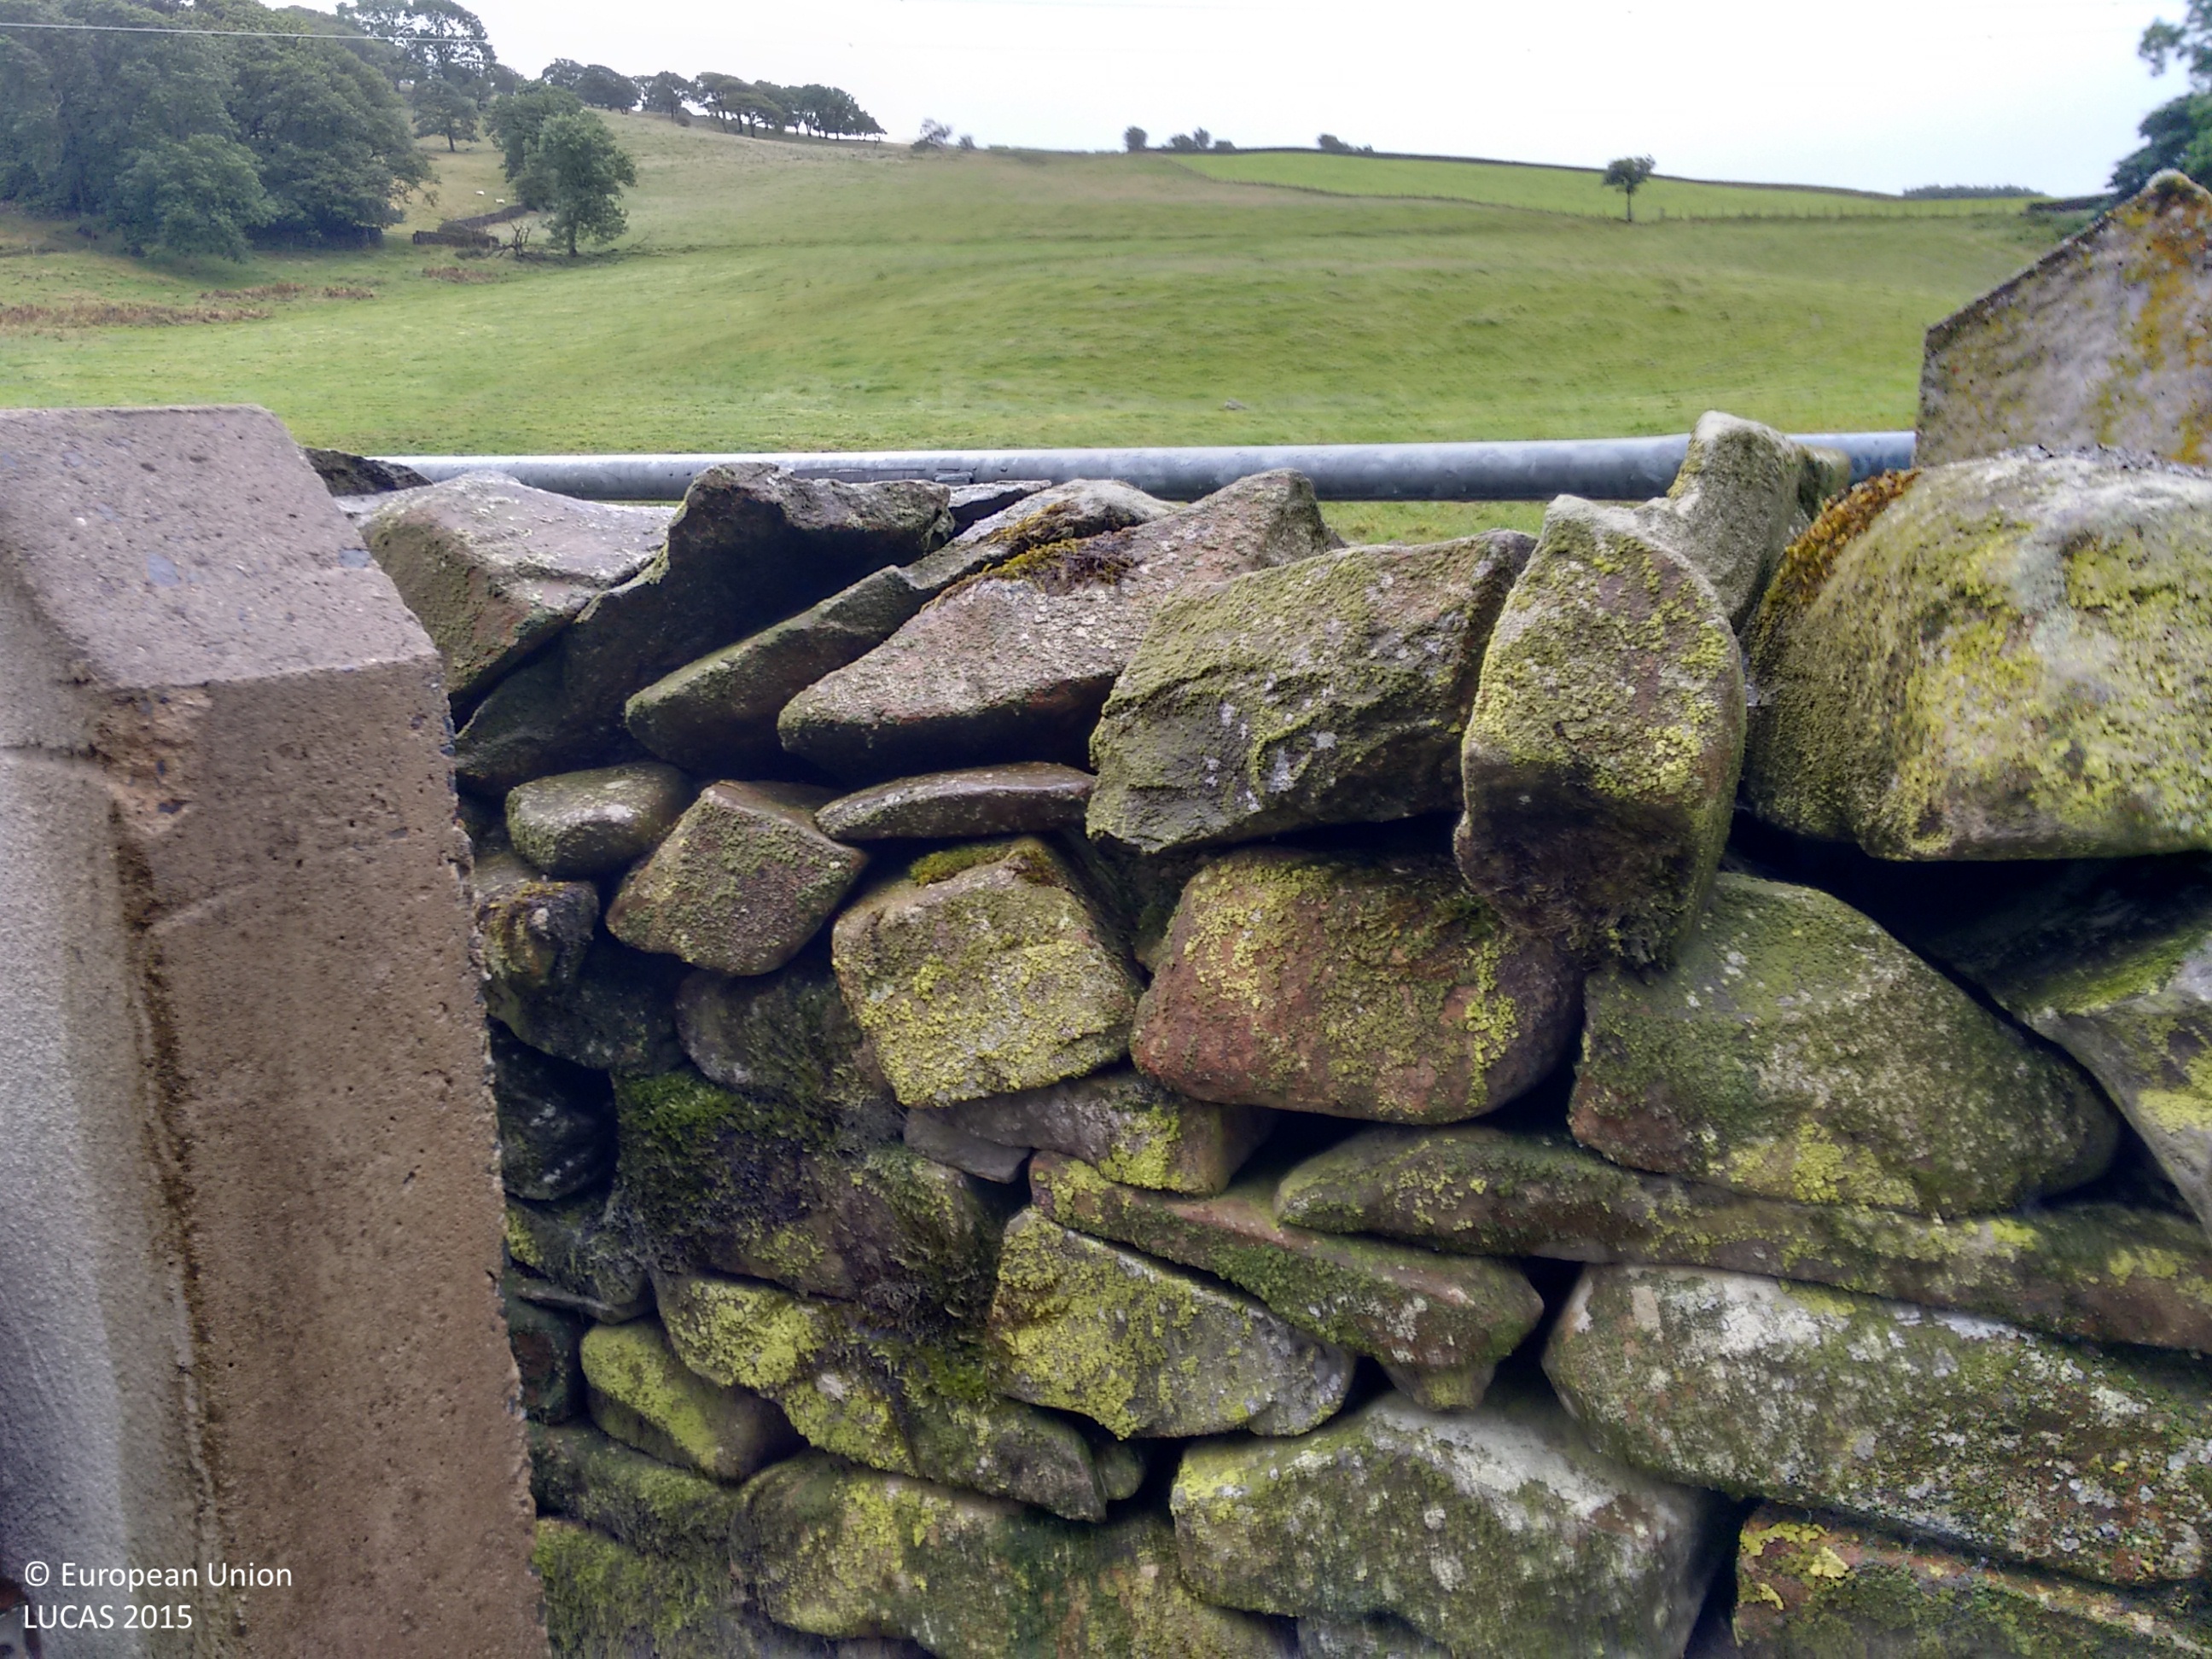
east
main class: Grassland
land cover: Grassland without tree/shrub cover
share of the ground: > 75 %
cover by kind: herbaceous plants 100 %
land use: Agriculture (excluding fallow land and kitchen gardens)
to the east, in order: Grassland without tree/shrub cover; Rock outcrops; Dry stone walls; Rock outcrops; Grassland with sparse tree/shrub cover
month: August
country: GB
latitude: 54.3365
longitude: -2.6631
